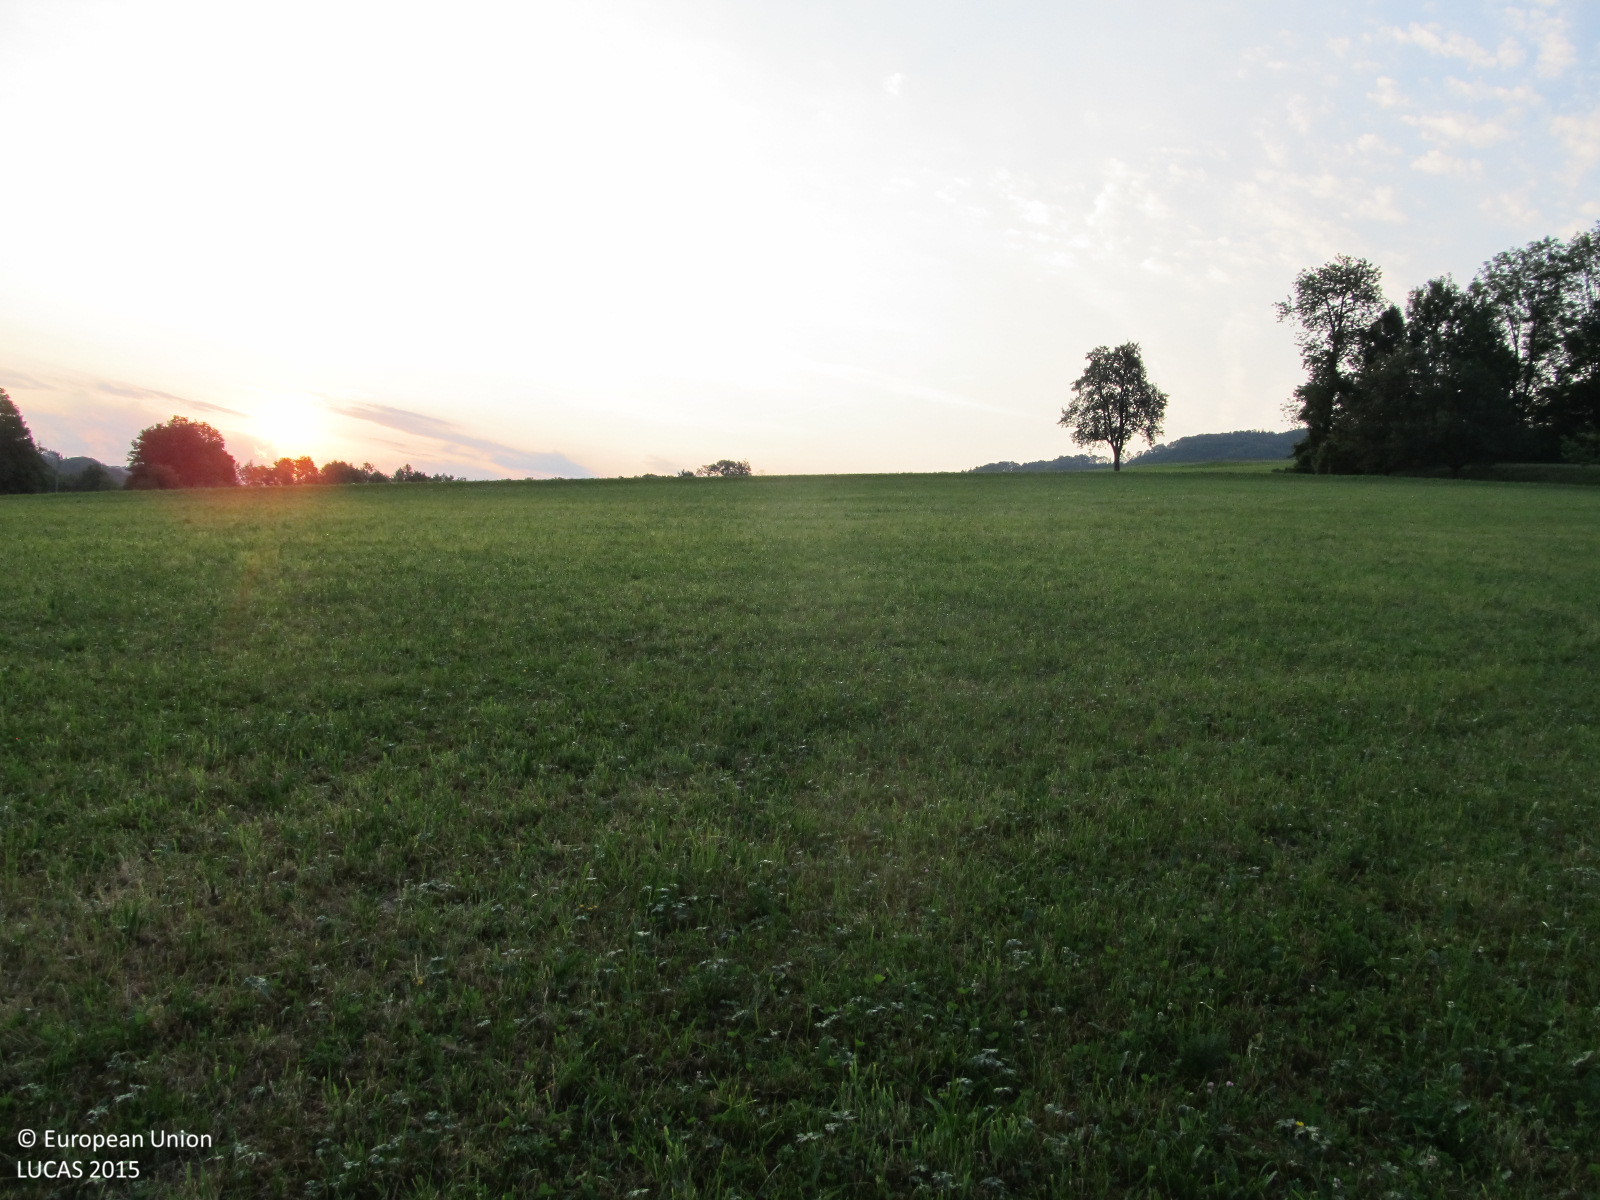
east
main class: Grassland
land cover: Grassland without tree/shrub cover
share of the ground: > 75 %
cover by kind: herbaceous plants 100 %
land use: Agriculture (excluding fallow land and kitchen gardens)
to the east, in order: Grassland without tree/shrub cover; Tracks; Grassland without tree/shrub cover; Ditches and canals; Grass margins; Paved roads, cycling and walking lanes; Grassland without tree/shrub cover
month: August
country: AT
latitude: 48.0573
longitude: 15.3552
